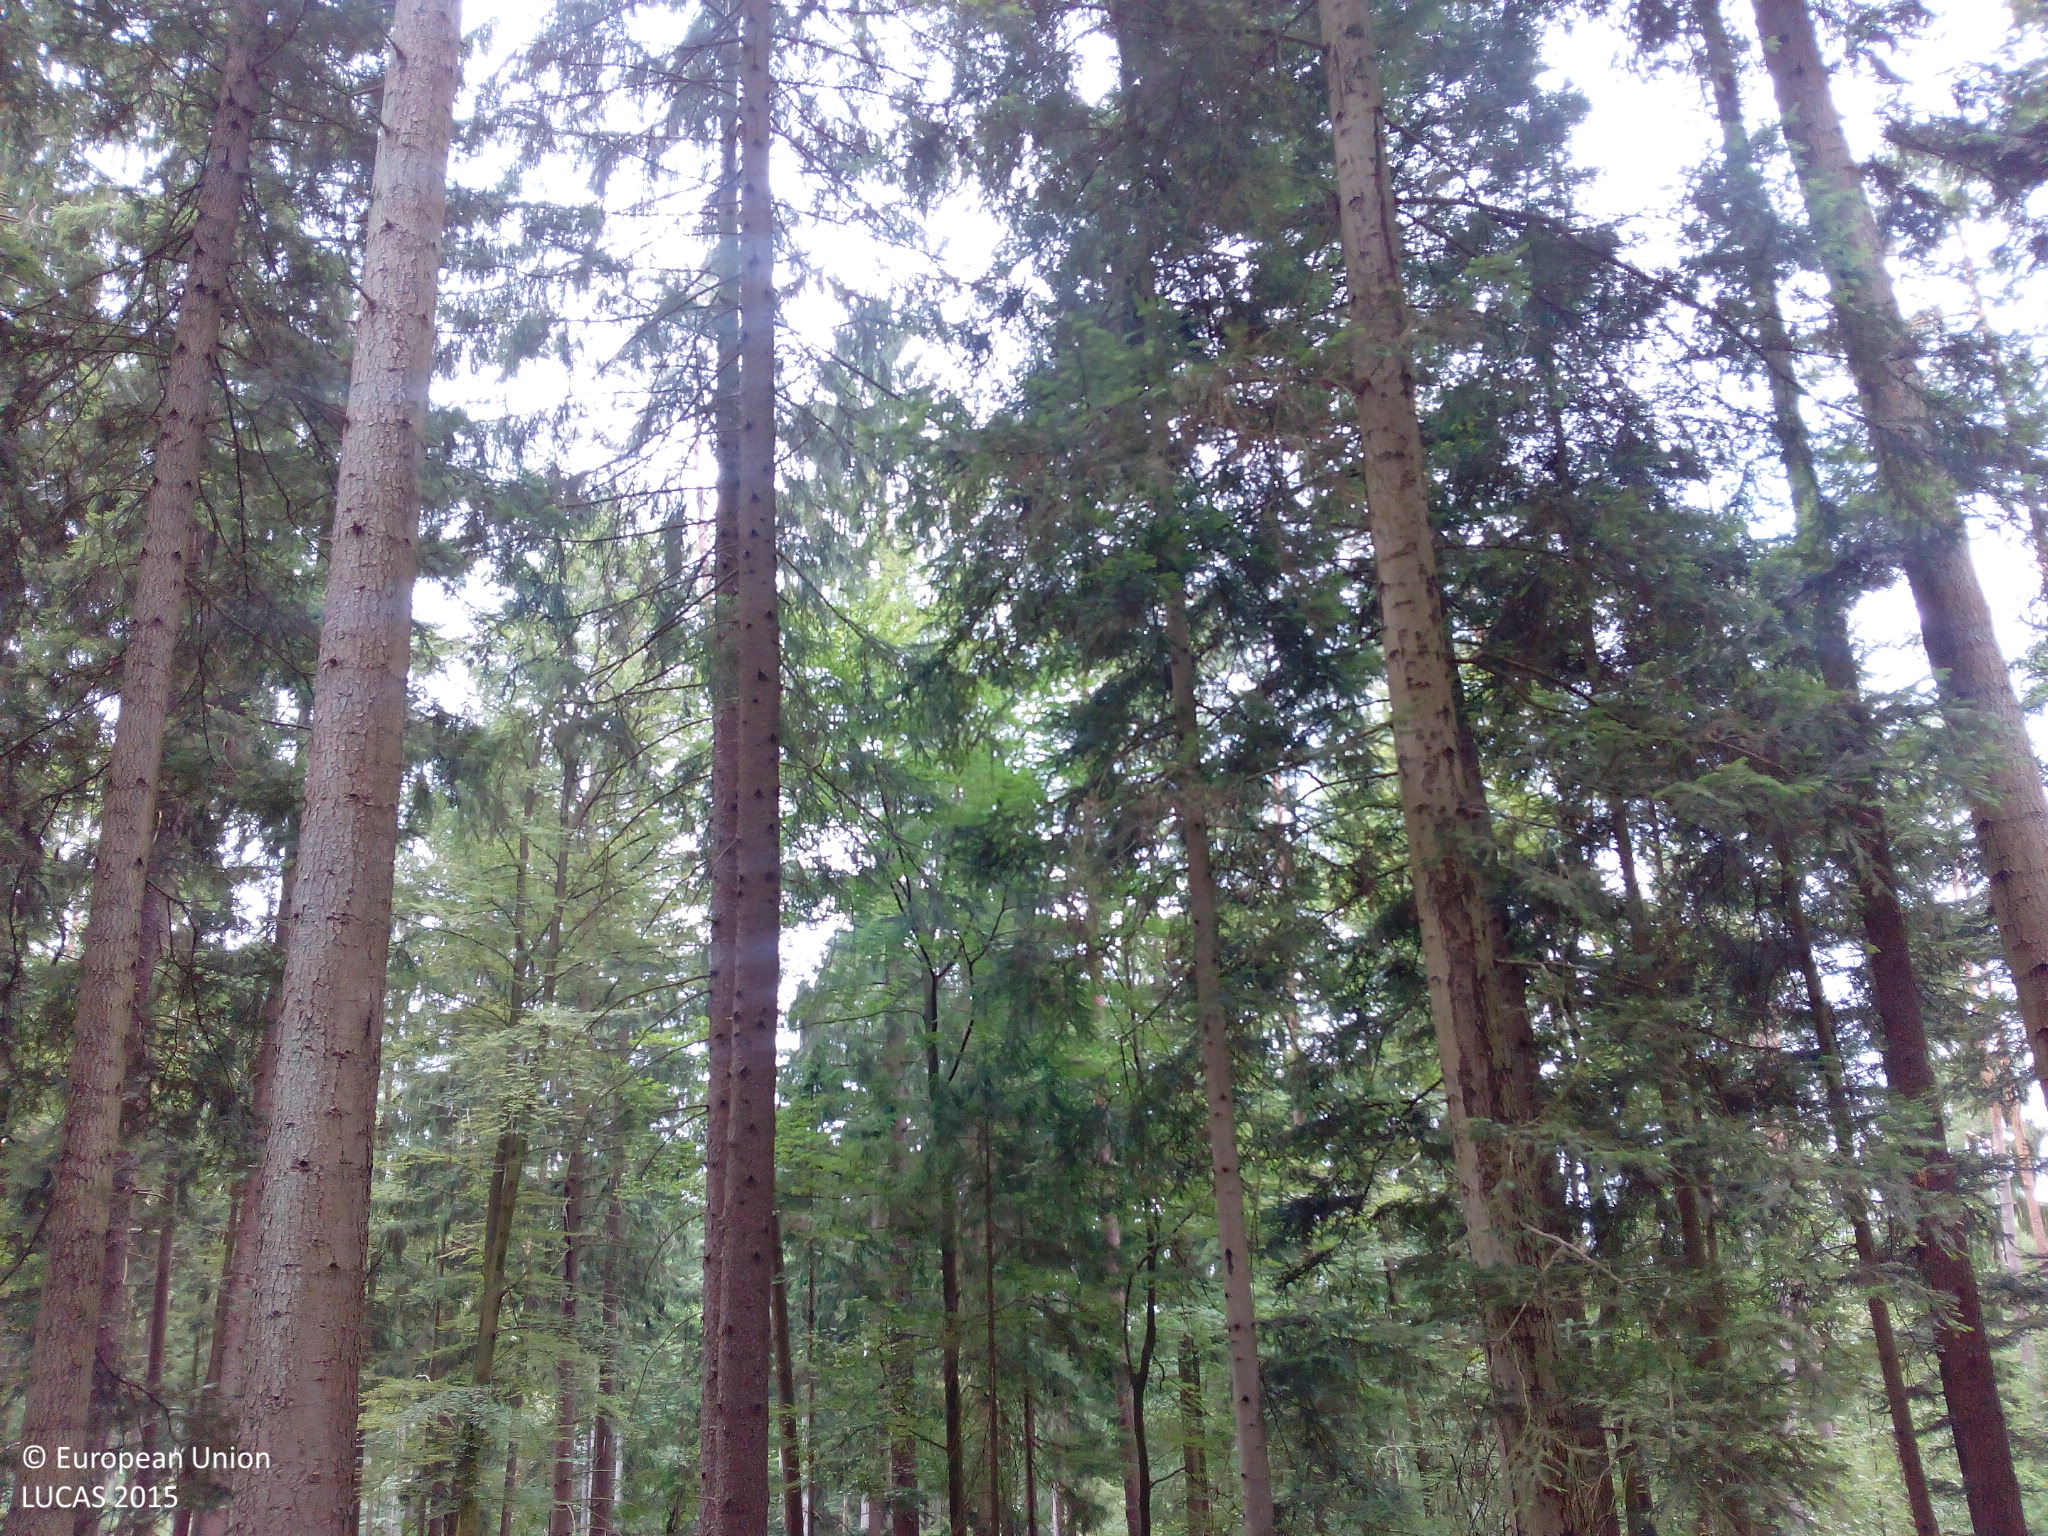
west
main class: Woodland
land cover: Other mixed woodland
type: hemiboreal forest and nemoral coniferous forest and mixed broadleaved-coniferous forest
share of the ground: > 75 %
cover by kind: coniferous forest trees 60 %, broadleaved forest trees 25 %, unconsolidated bare surface 10 %, herbaceous plants 5 %
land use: Forestry
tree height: > 5 m
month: July
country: DE
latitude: 49.1155
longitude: 7.6030
